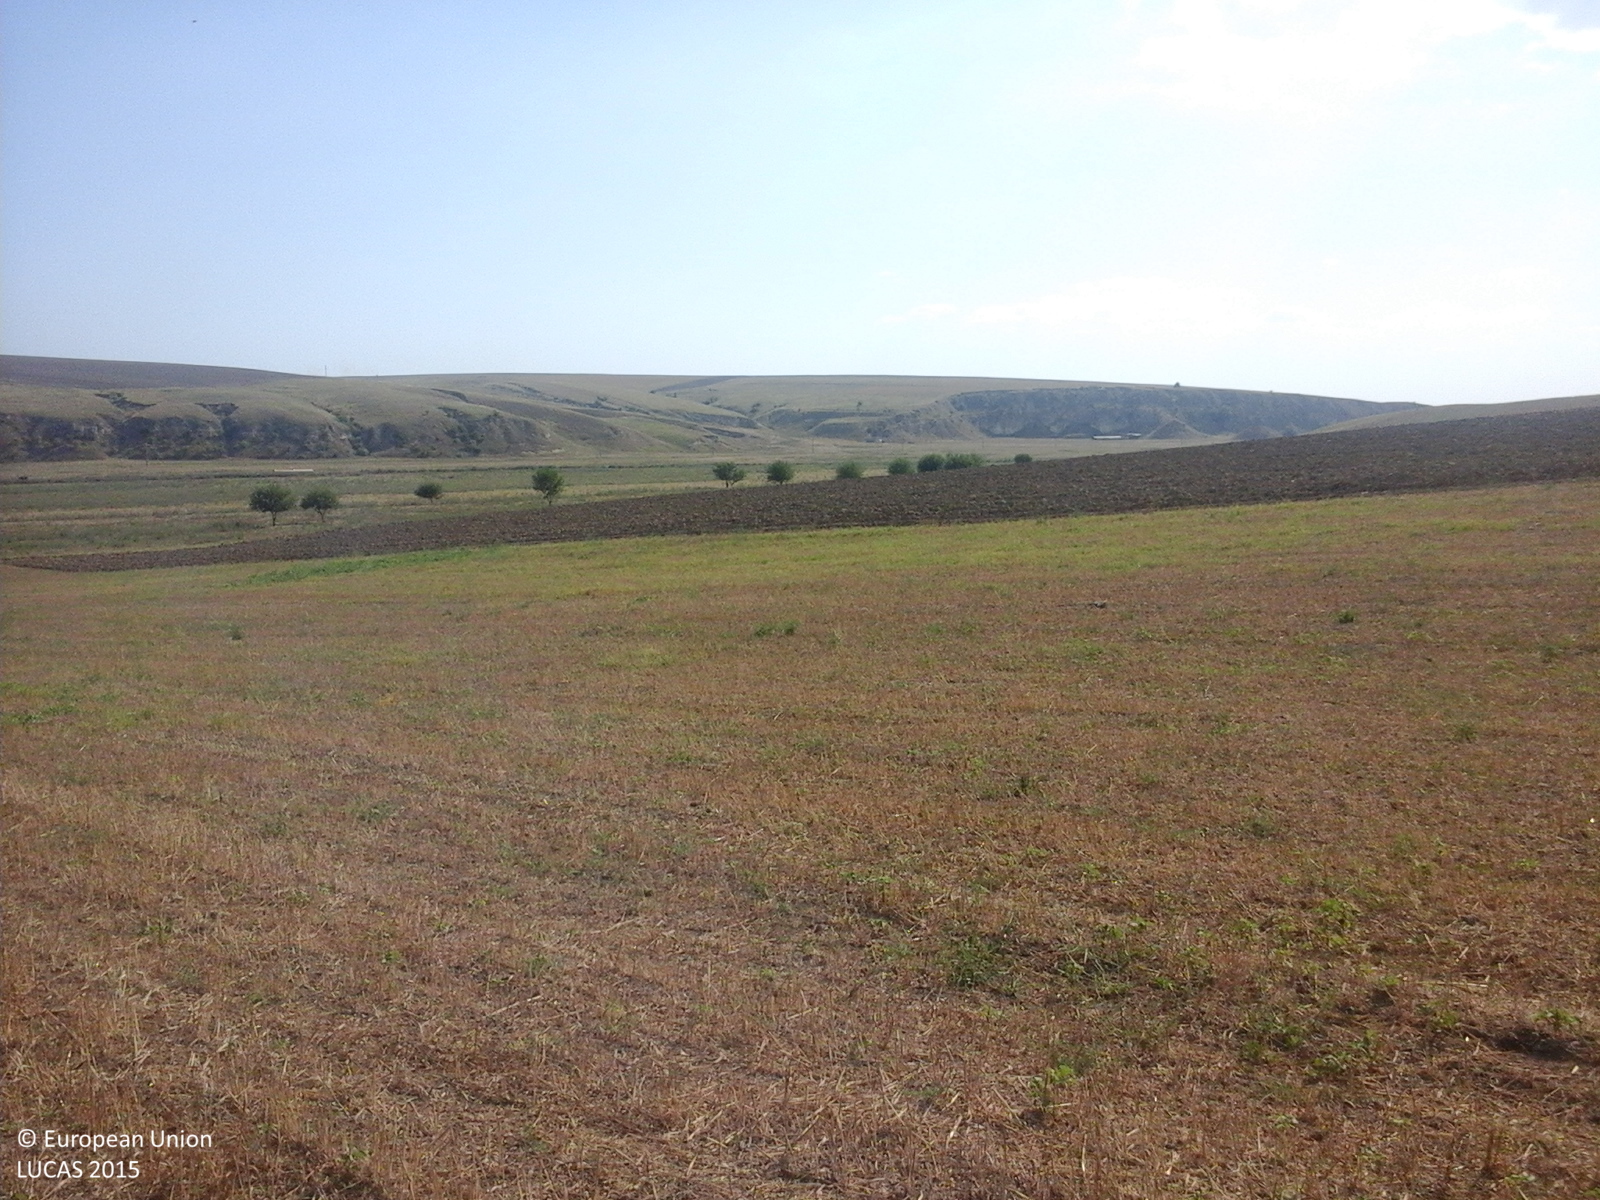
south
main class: Cropland
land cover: Oats
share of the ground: 25 - 50 %
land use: Agriculture (excluding fallow land and kitchen gardens)
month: August
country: RO
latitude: 44.5941
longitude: 28.0616
